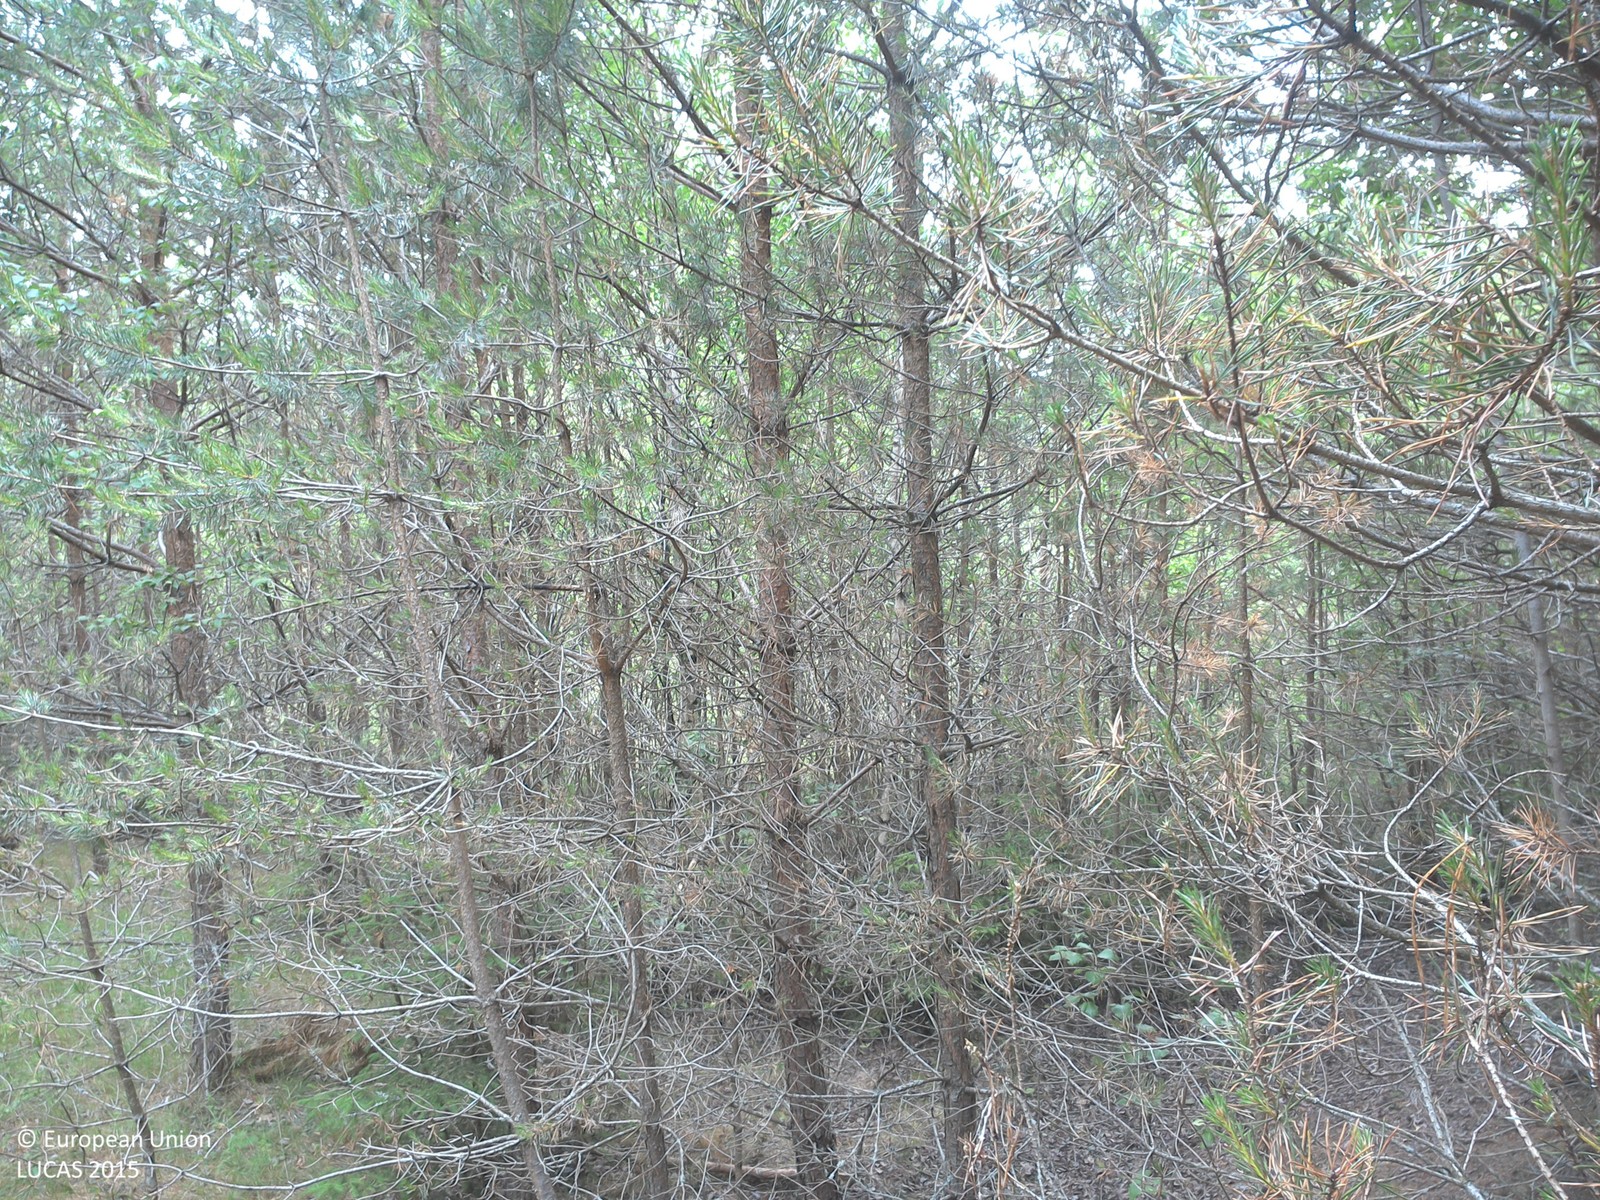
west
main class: Woodland
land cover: Pine dominated coniferous woodland
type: boreal forest
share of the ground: > 75 %
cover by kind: coniferous forest trees 85 %, unconsolidated bare surface 15 %
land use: Forestry
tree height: > 5 m
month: June
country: SE
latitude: 58.3754
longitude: 15.5517
